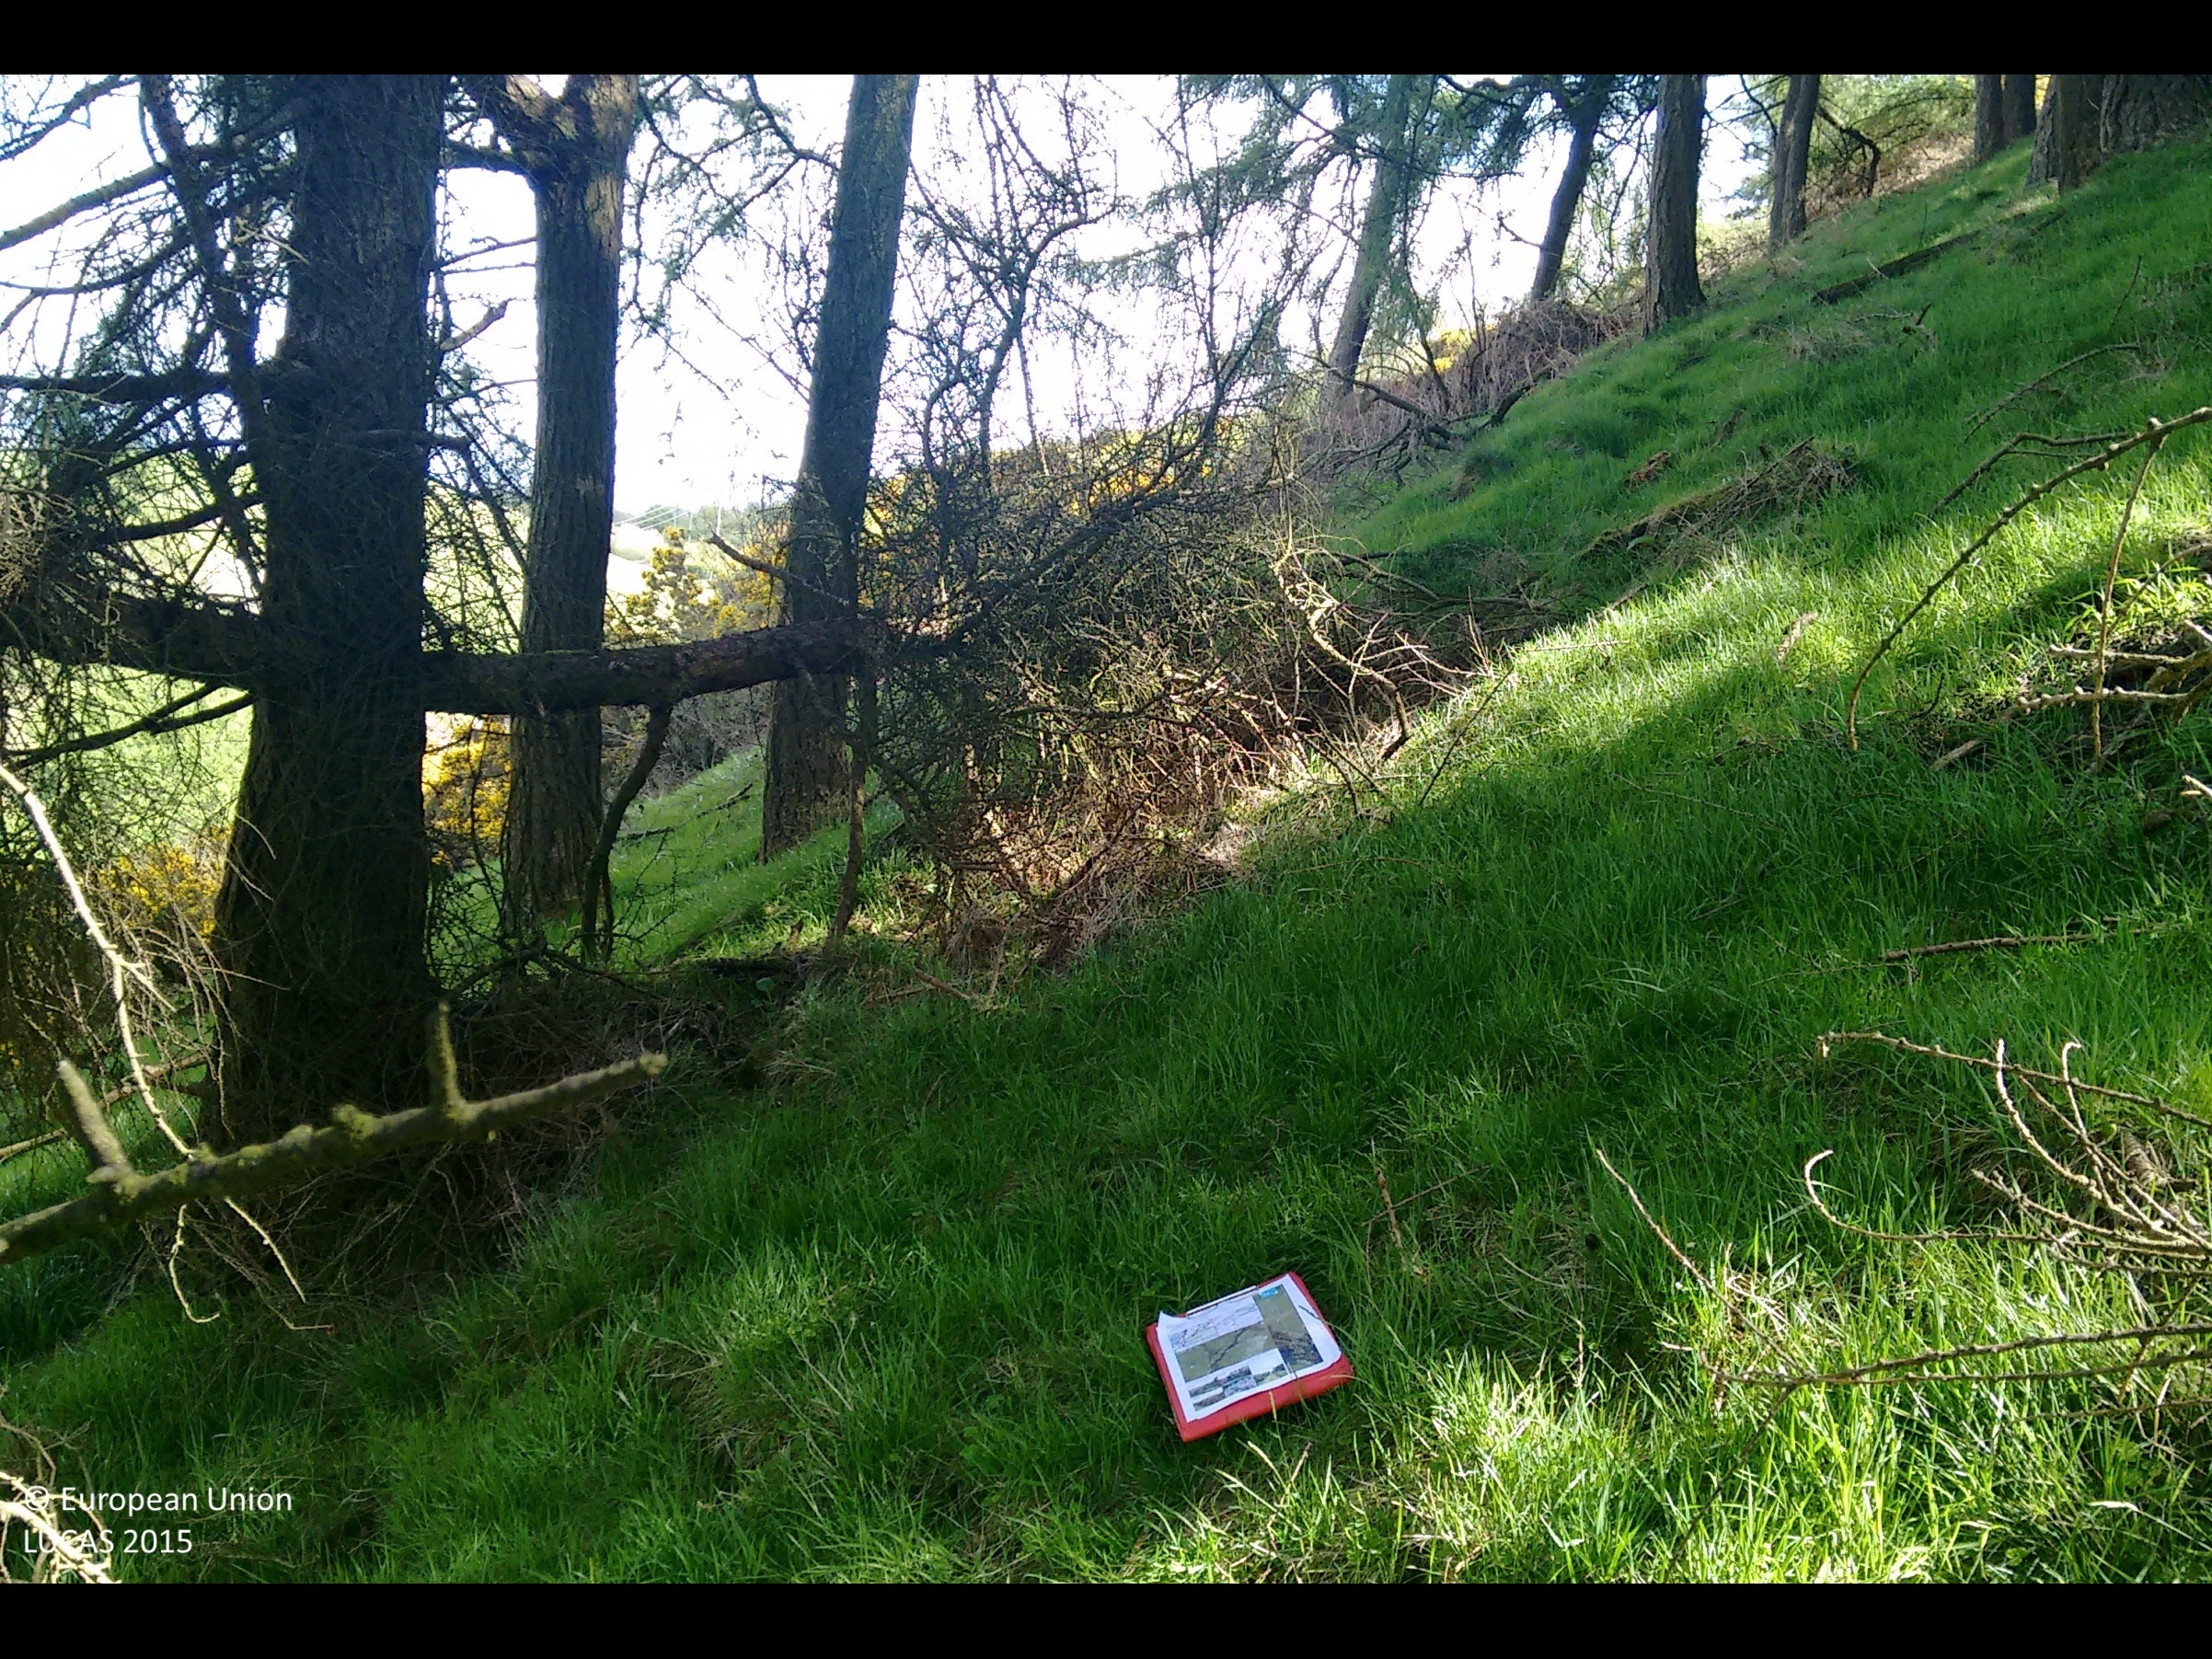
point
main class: Woodland
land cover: Pine dominated coniferous woodland
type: exotic forest
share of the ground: > 75 %
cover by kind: coniferous forest trees 100 %
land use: Semi-natural and natural areas not in use
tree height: > 5 m
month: May
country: GB
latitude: 54.0799
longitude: -2.6777
